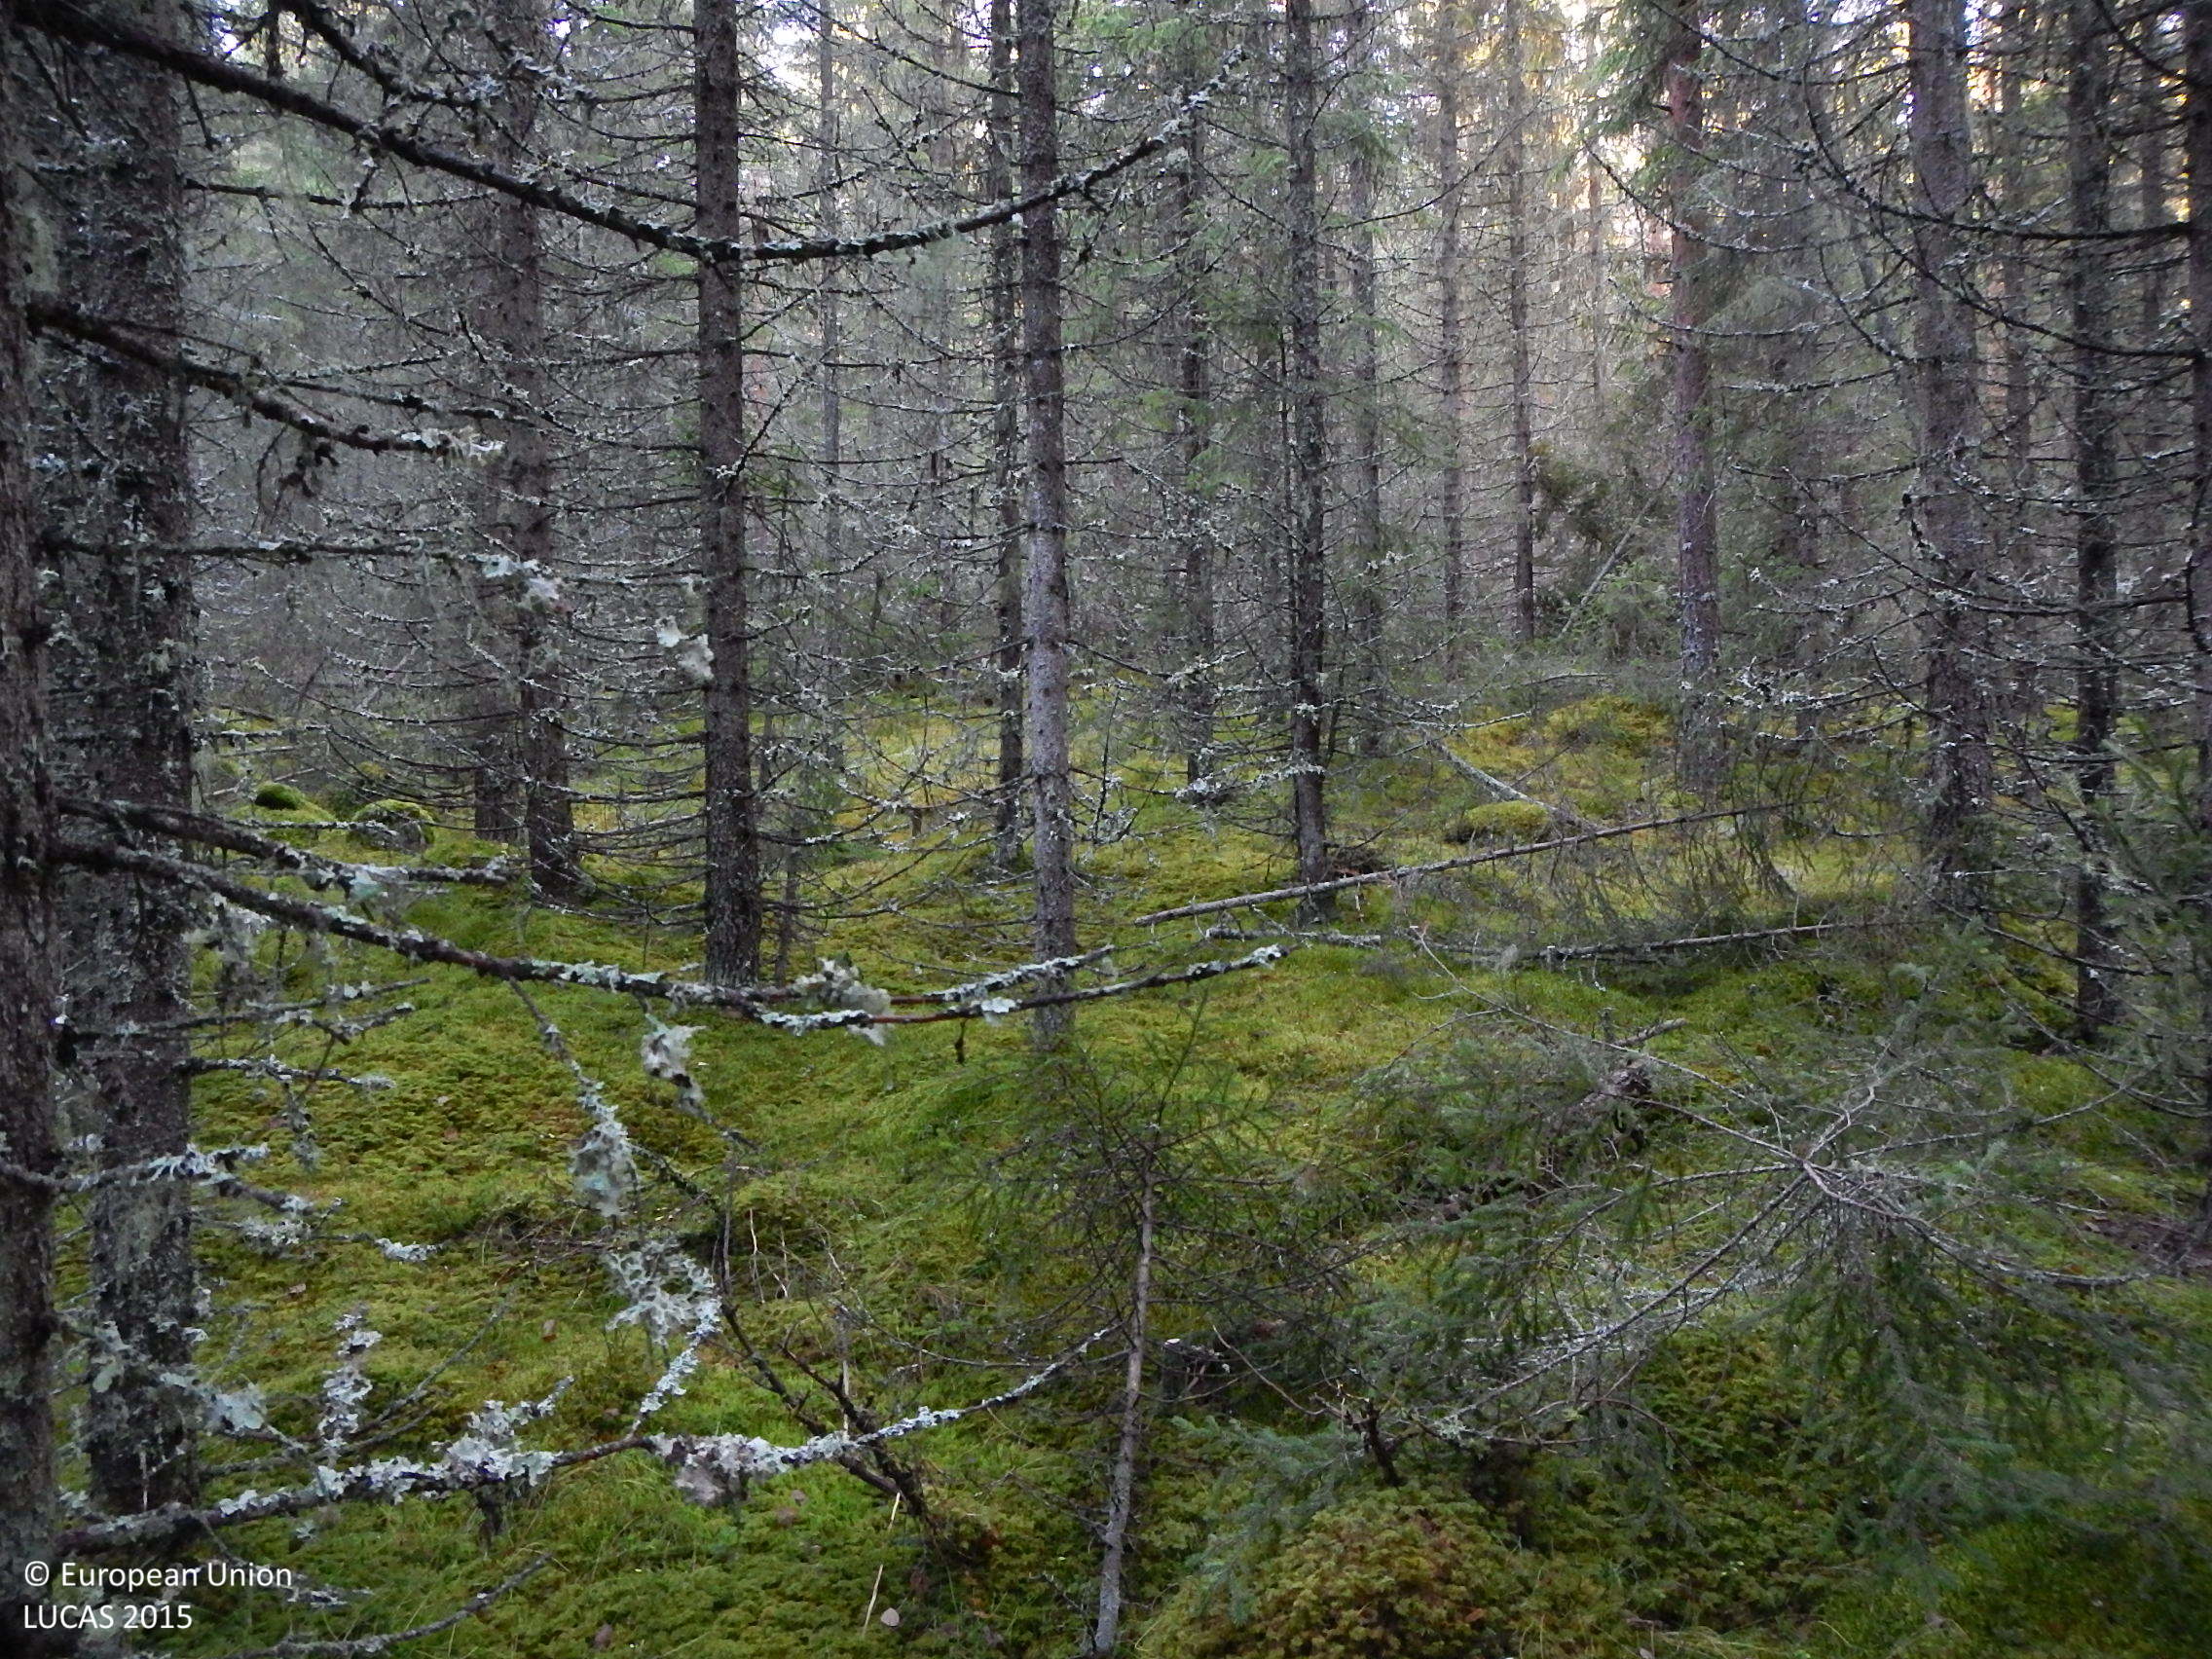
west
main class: Woodland
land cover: Spruce dominated coniferous woodland
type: boreal forest
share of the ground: > 75 %
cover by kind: coniferous forest trees 90 %, lichens and mosses 10 %
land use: Forestry
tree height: > 5 m
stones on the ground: < 10 %
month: November
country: SE
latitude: 61.5155
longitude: 15.5663
